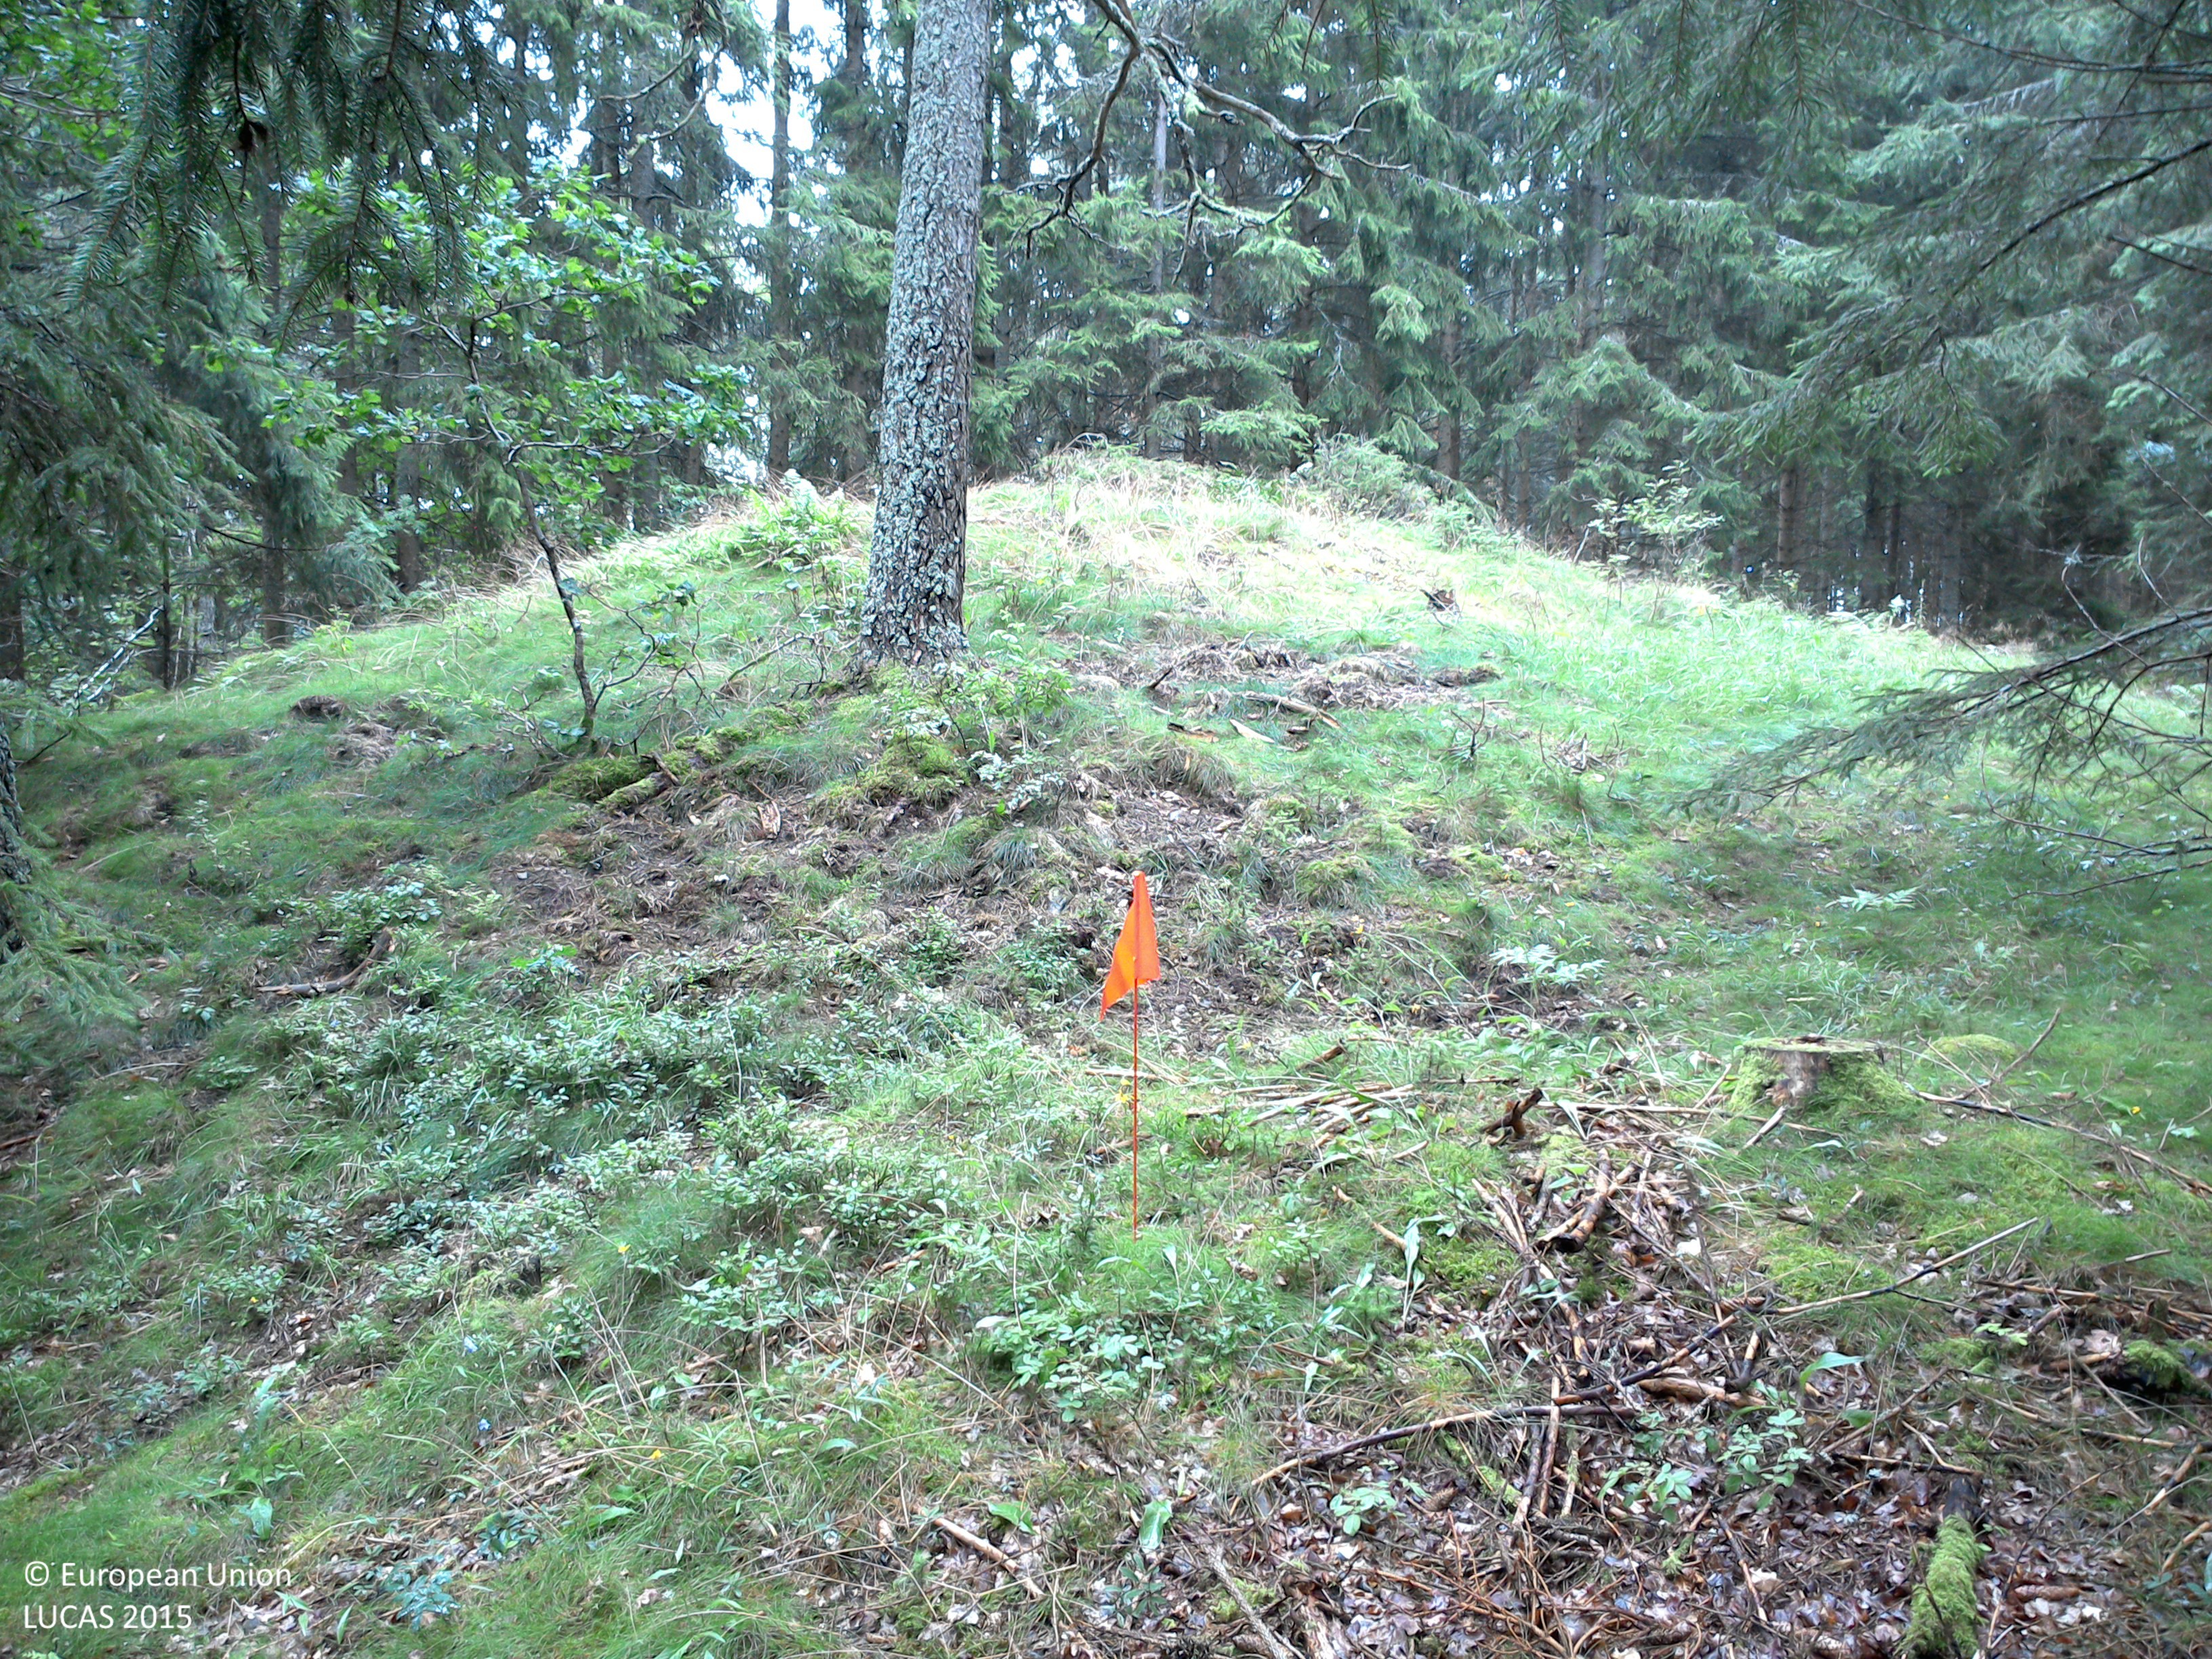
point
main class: Woodland
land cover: Spruce dominated coniferous woodland
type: boreal forest
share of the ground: 50 - 75 %
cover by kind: coniferous forest trees 60 %, herbaceous plants 40 %
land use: Forestry
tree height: > 5 m
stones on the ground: < 10 %
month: August
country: SE
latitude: 58.2527
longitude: 15.4645
